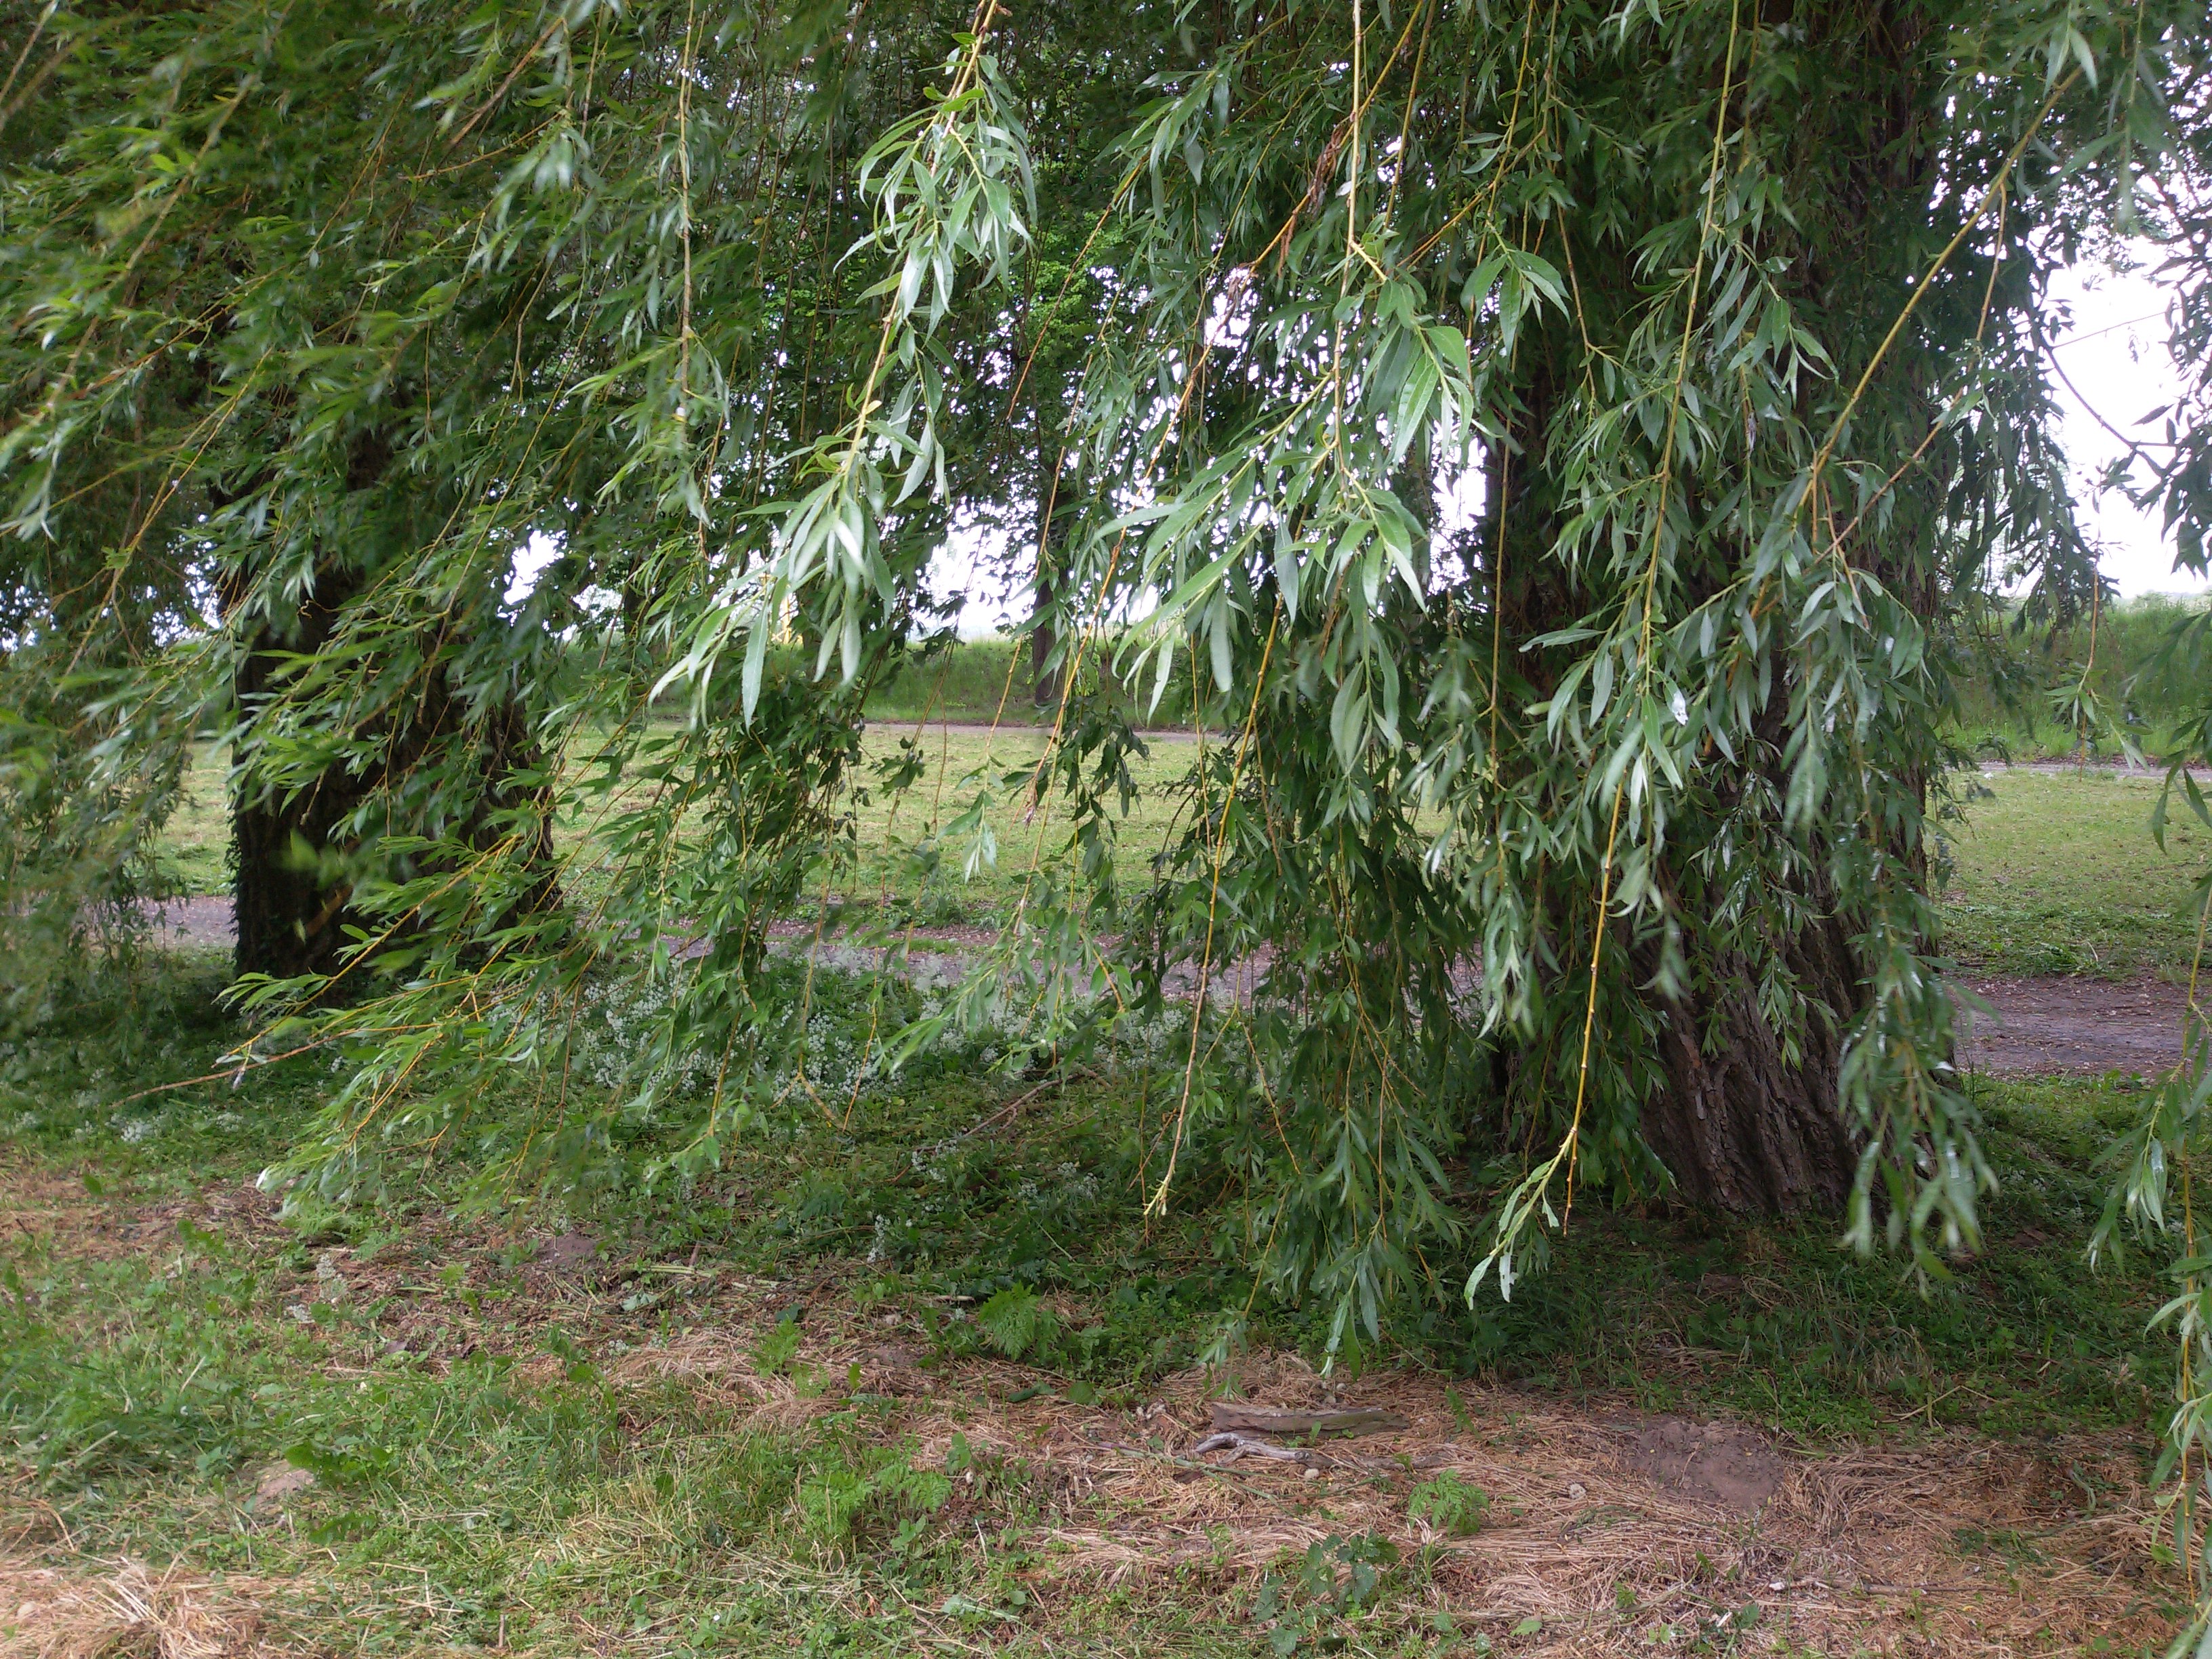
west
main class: Grassland
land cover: Grassland with sparse tree/shrub cover
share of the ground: > 75 %
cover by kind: herbaceous plants 95 %, broadleaved forest trees 5 %
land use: Amenities, museums, leisure
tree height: > 5 m
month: May
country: PL
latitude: 53.2470
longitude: 14.4821
